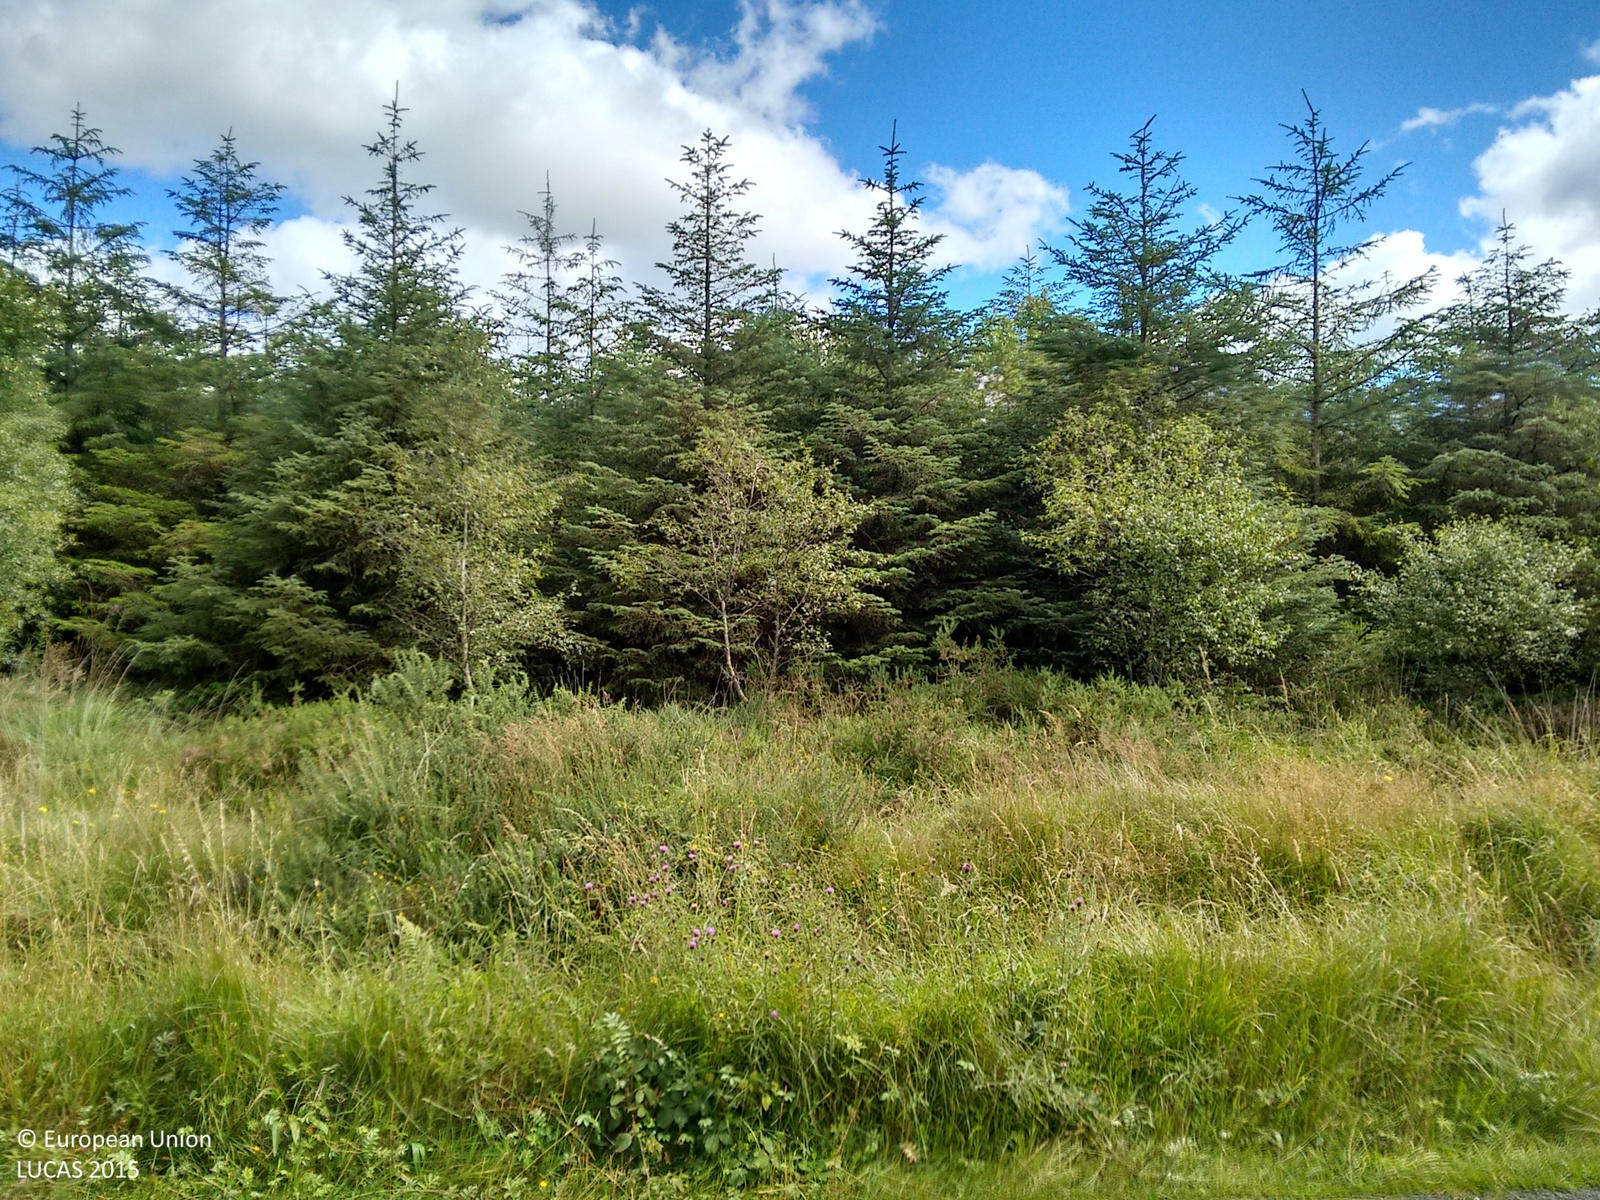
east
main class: Woodland
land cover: Other mixed woodland
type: exotic forest
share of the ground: > 75 %
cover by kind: coniferous forest trees 50 %, broadleaved forest trees 50 %
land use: Forestry
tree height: < 5 m
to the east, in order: Other mixed woodland; Broadleaved woodland; Fences; Broadleaved woodland; Ditches and canals; Grass margins; Paved roads, cycling and walking lanes; Grass margins; Ditches and canals; Shruby margins; Ditches and canals; Spruce dominated coniferous woodland
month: August
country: IE
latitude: 52.3728
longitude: -7.1115
